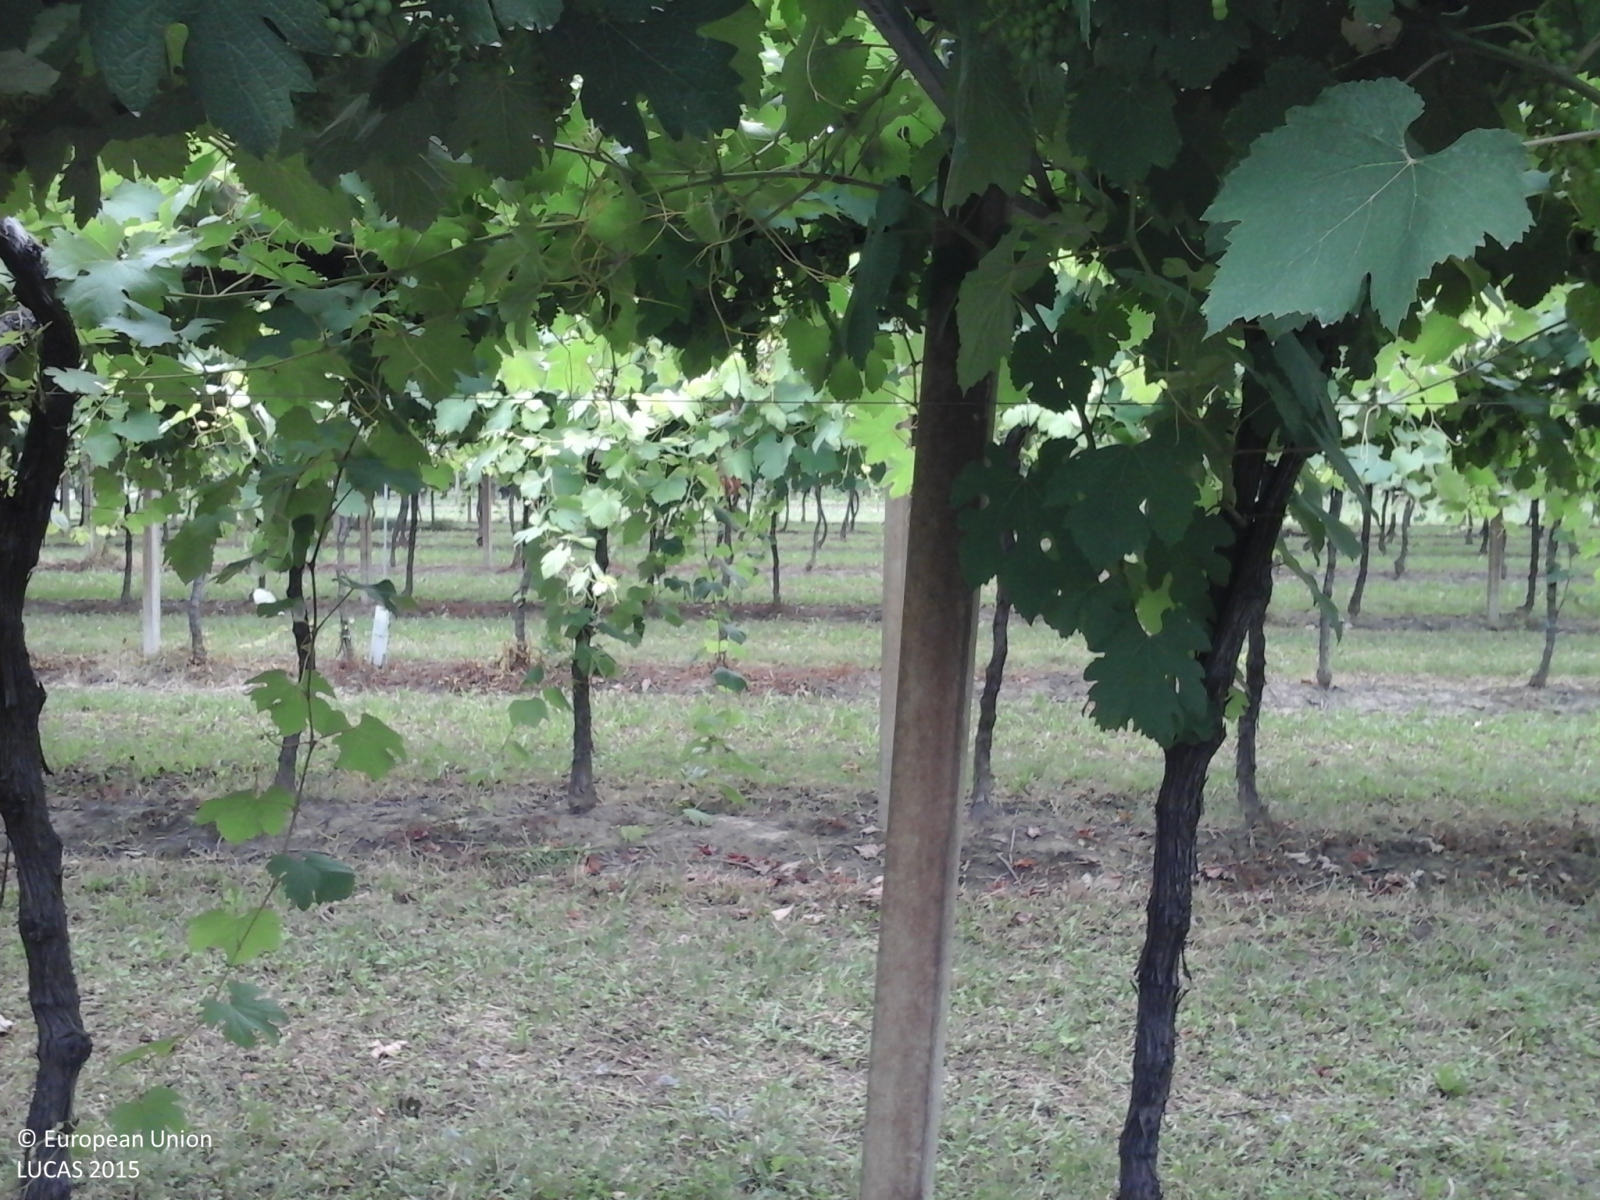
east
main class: Cropland
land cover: Vineyards
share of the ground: 50 - 75 %
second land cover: Grassland without tree/shrub cover
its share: > 75 %
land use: Agriculture (excluding fallow land and kitchen gardens)
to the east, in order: Vineyards; Grassland without tree/shrub cover; Ditches and canals; Grass margins; Pear fruit; Paved roads, cycling and walking lanes; Pear fruit; Grass margins; Ditches and canals; Grass margins; Pear fruit
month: June
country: IT
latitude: 44.7062
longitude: 11.0202
